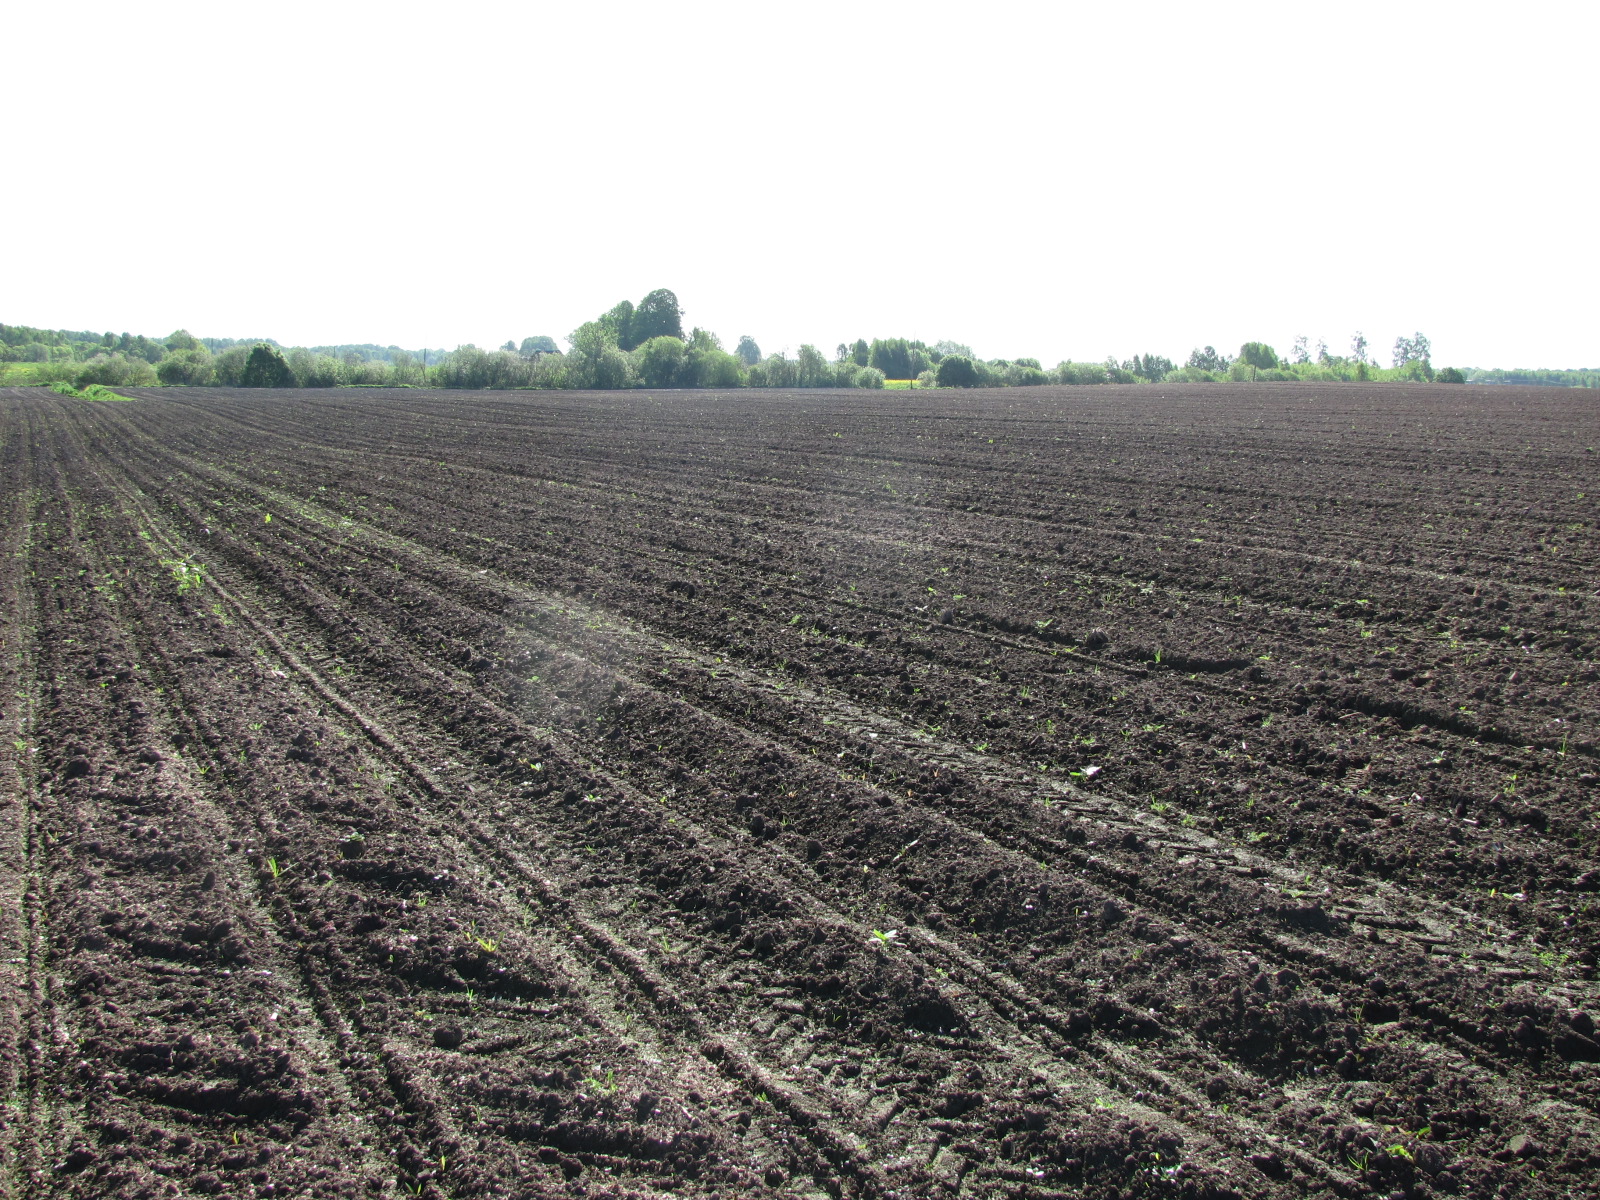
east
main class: Cropland
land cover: Maize
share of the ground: < 10 %
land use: Agriculture (excluding fallow land and kitchen gardens)
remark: Tilled/Sowed
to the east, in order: Maize
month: May
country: LV
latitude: 56.6162
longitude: 24.2172
